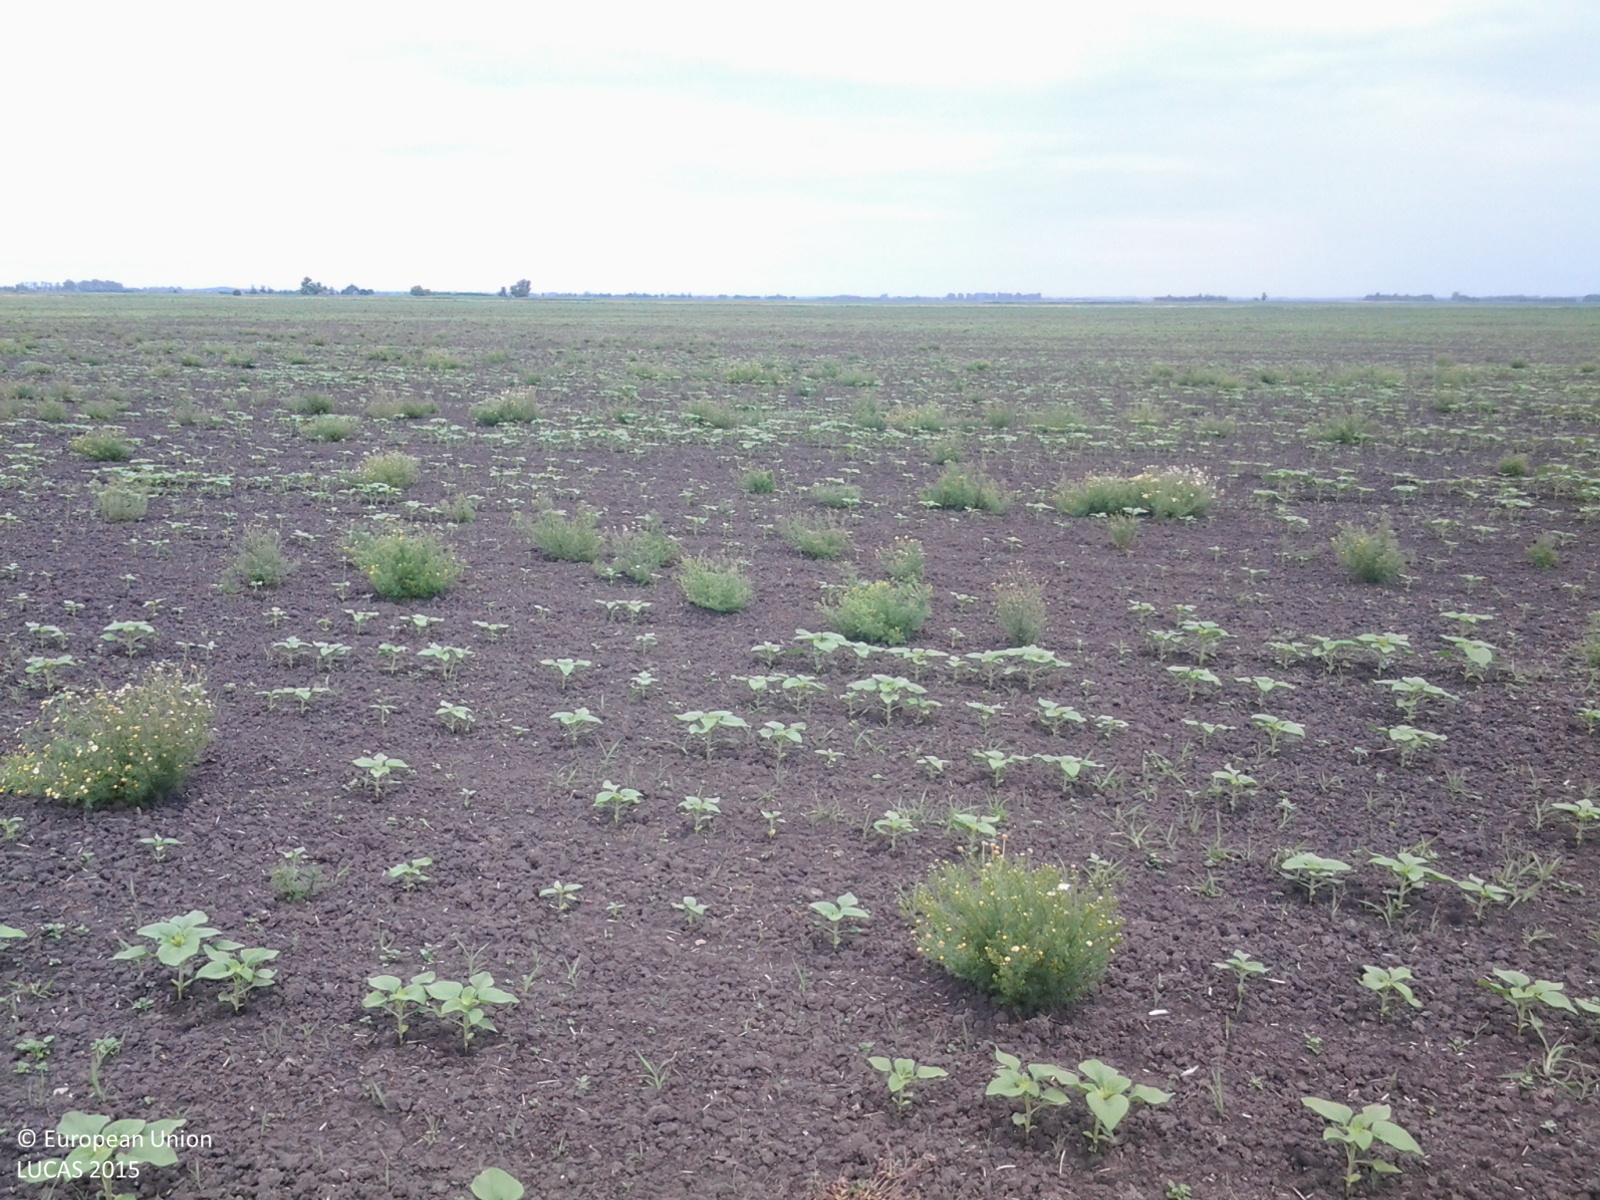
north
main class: Cropland
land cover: Sunflower
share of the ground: < 10 %
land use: Agriculture (excluding fallow land and kitchen gardens)
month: June
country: HU
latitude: 46.8210
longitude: 20.4215
